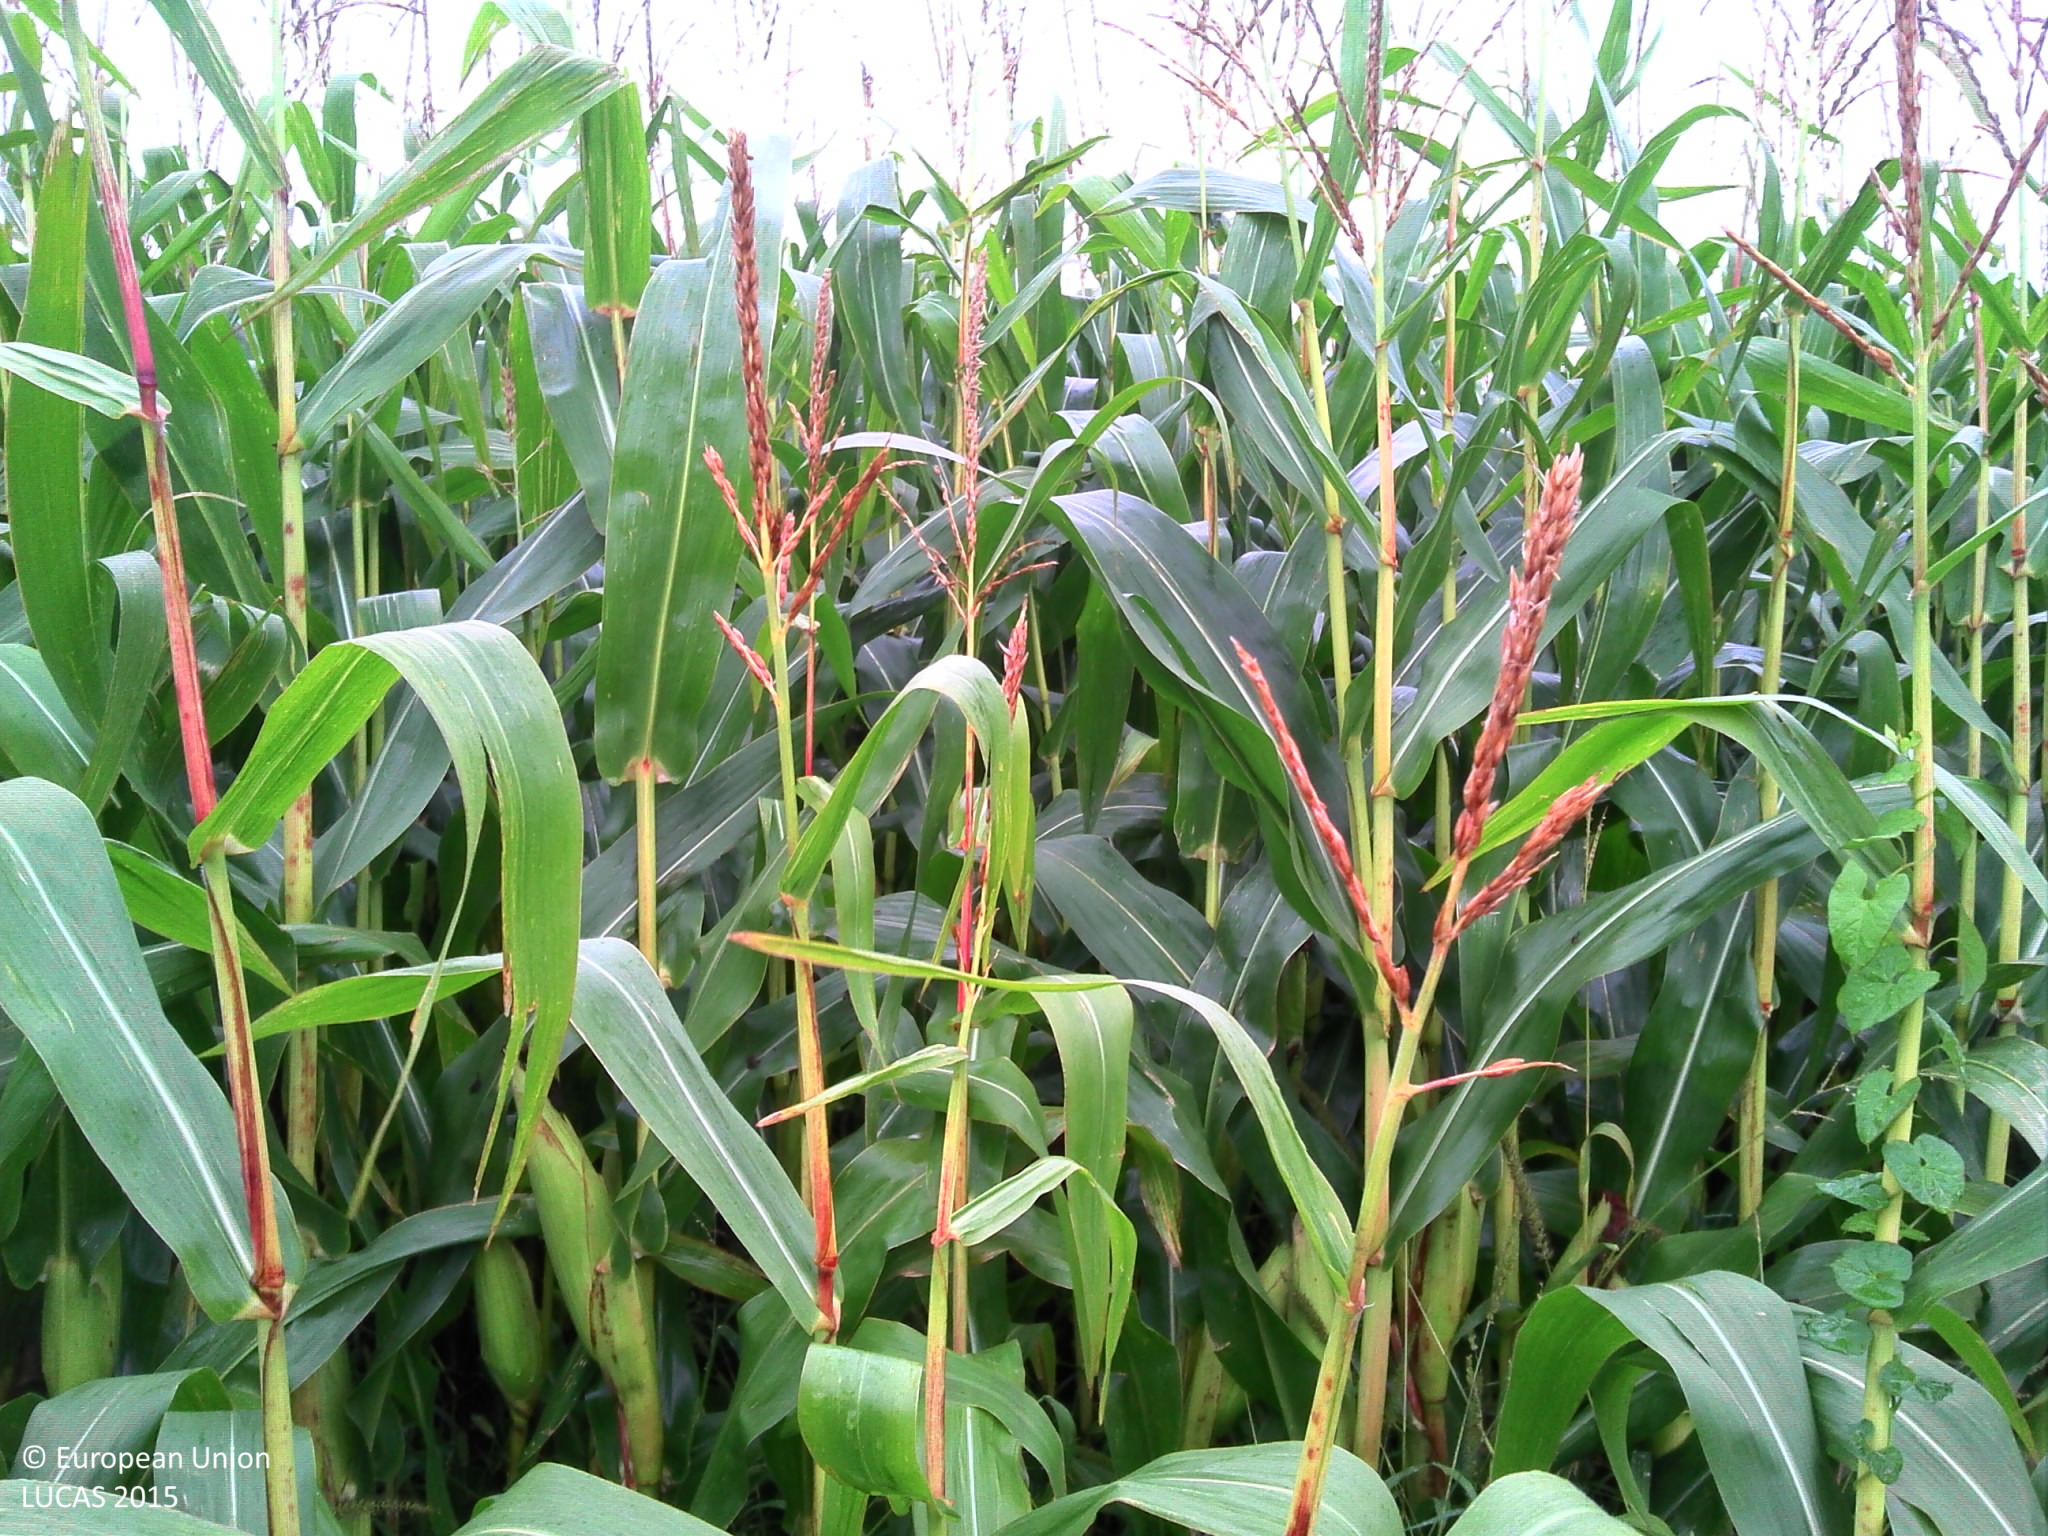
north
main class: Cropland
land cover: Maize
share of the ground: > 75 %
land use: Agriculture (excluding fallow land and kitchen gardens)
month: September
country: BE
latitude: 51.1635
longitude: 3.0546
